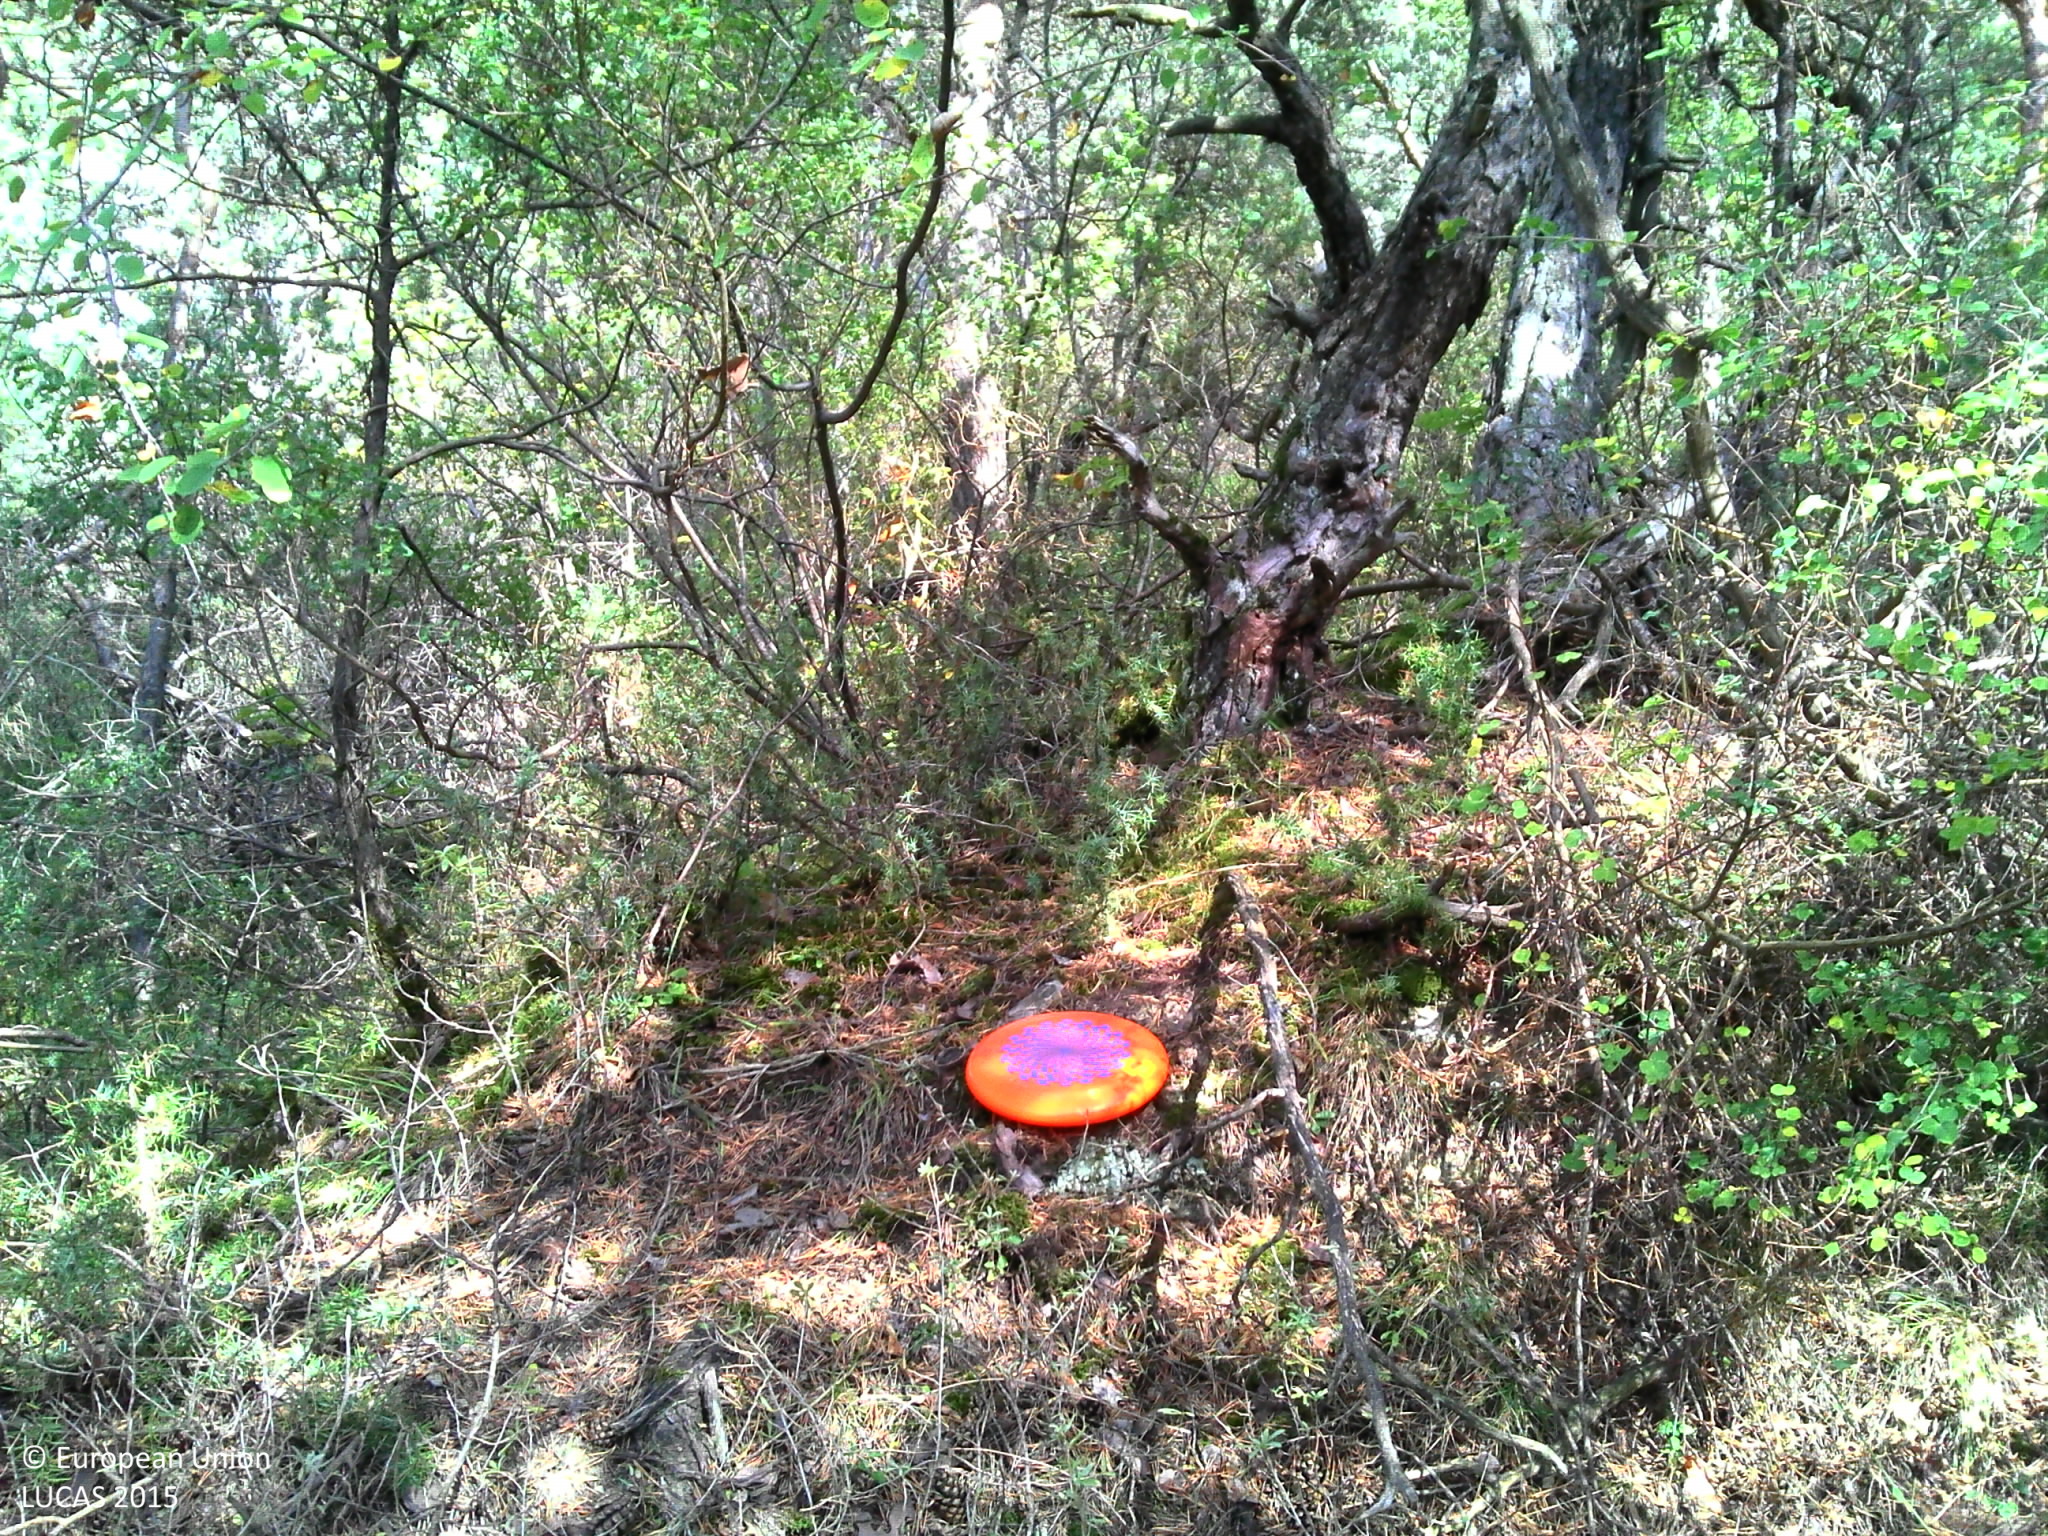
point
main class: Woodland
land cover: Pine dominated coniferous woodland
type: hemiboreal forest and nemoral coniferous forest and mixed broadleaved-coniferous forest
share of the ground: > 75 %
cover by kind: coniferous forest trees 70 %, broadleaved forest trees 10 %, shrubs 10 %, herbaceous plants 5 %, consolidated bare surface 5 %
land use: Forestry
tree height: > 5 m
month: September
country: FR
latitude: 44.5344
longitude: 6.2187
